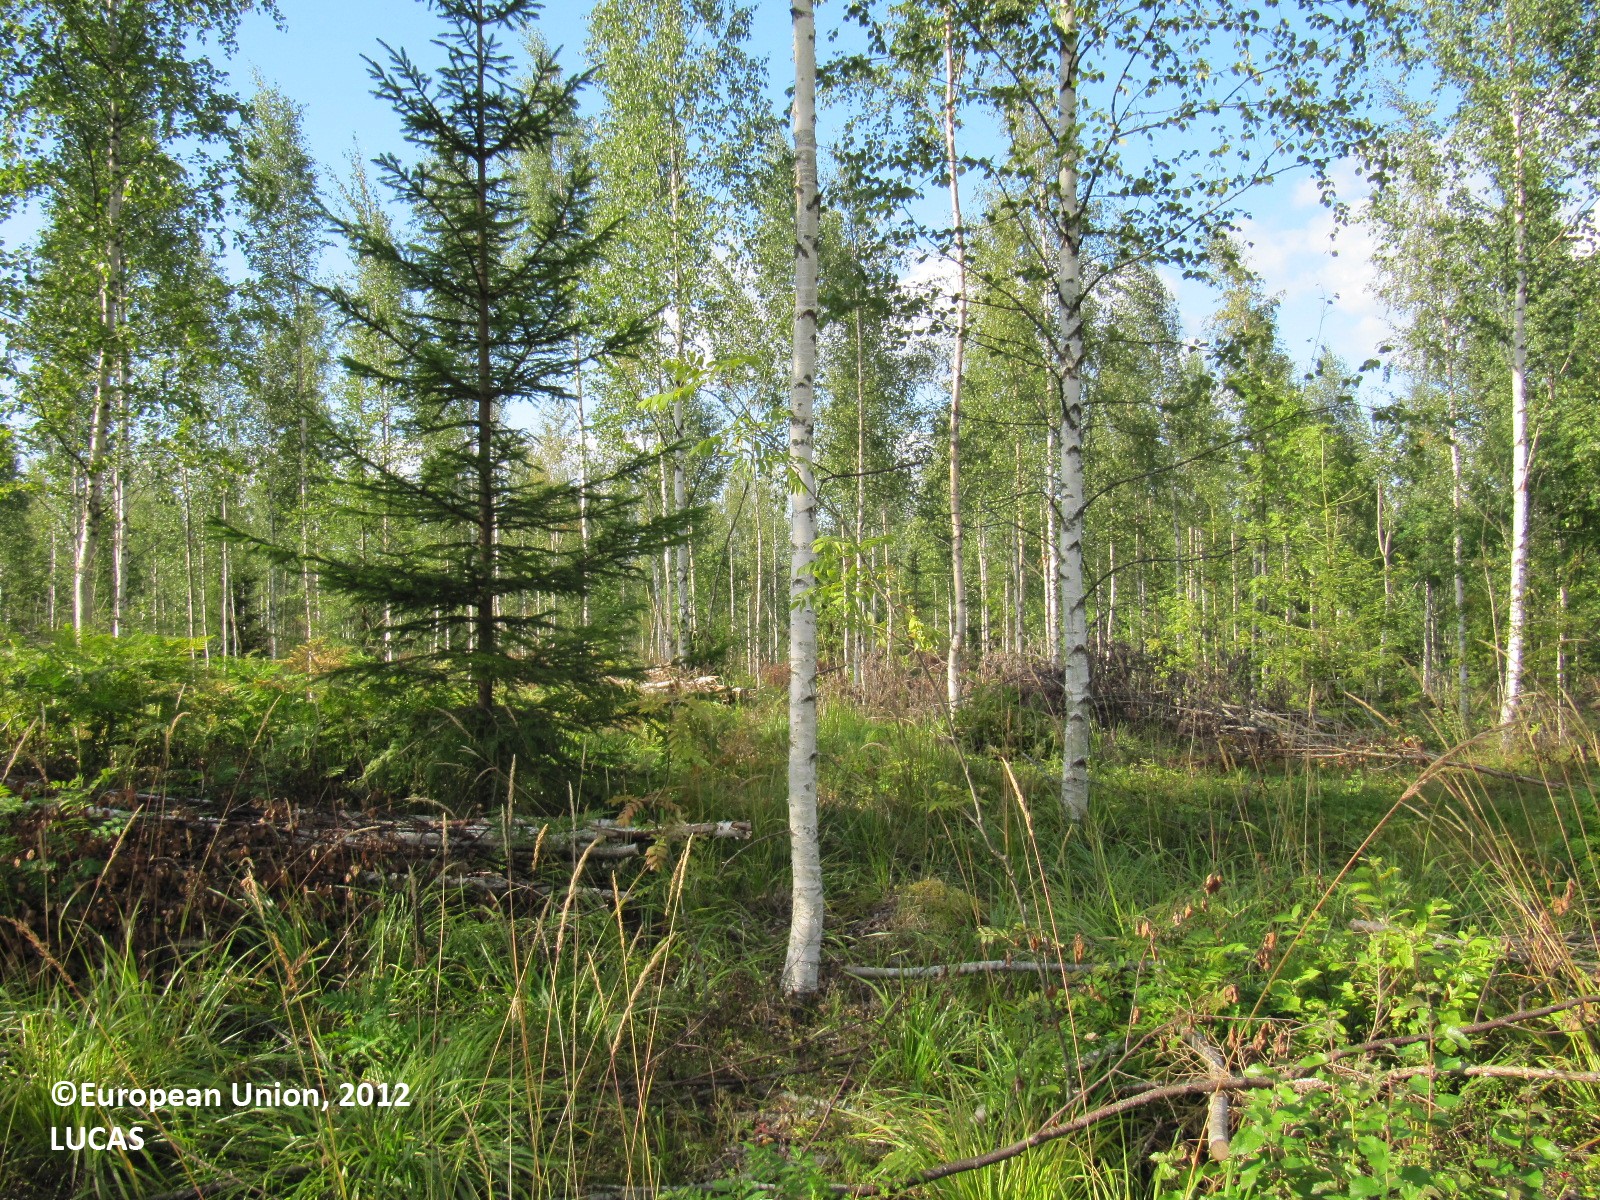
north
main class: Woodland
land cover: Other mixed woodland
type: boreal forest
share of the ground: 25 - 50 %
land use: Forestry
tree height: > 5 m
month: August
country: FI
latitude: 60.5953
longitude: 24.5496
